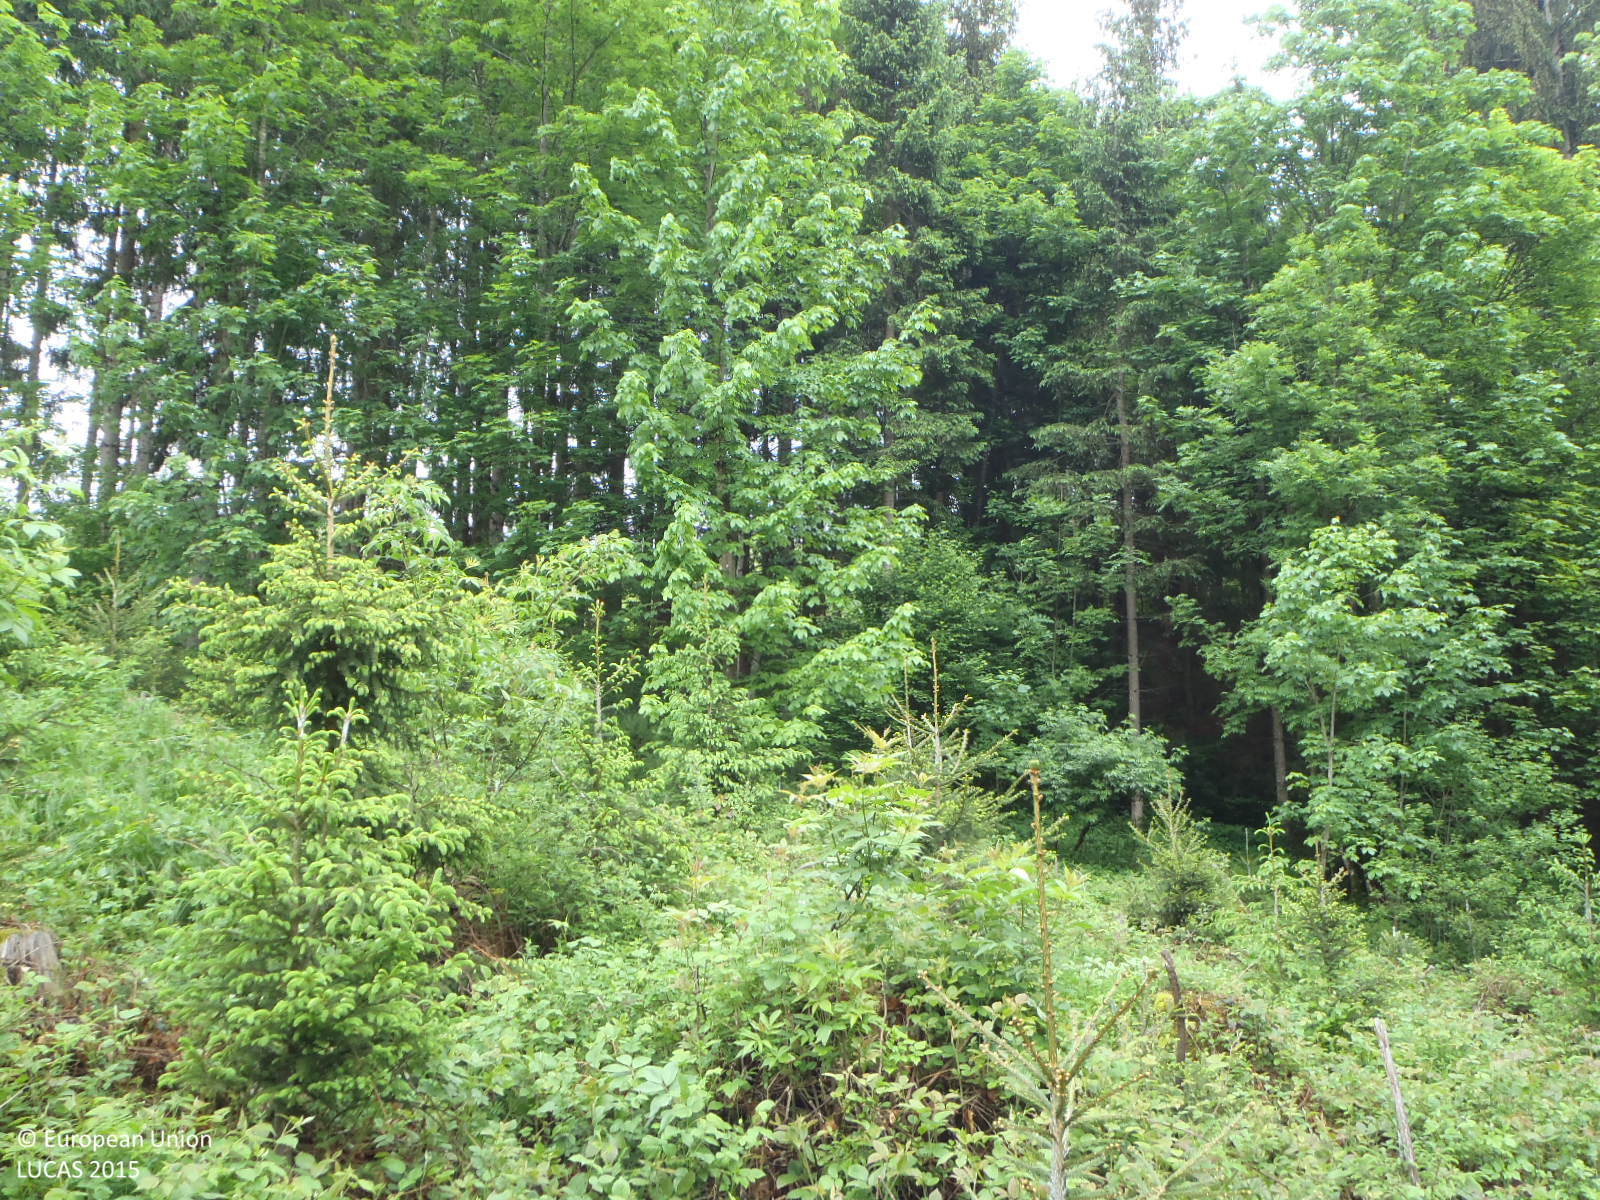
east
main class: Woodland
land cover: Other mixed woodland
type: alpine coniferous forest
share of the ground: > 75 %
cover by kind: coniferous forest trees 60 %, broadleaved forest trees 25 %, herbaceous plants 15 %
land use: Forestry
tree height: > 5 m
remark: Nursery
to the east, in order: Other mixed woodland; Spruce dominated coniferous woodland; Fences; Tracks; Fences; Grassland without tree/shrub cover; Fences; Grassland without tree/shrub cover; Artificial constructions in urban areas; Grassland without tree/shrub cover; Fences; Grassland without tree/shrub cover; Fences; Grassland without tree/shrub cover
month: May
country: AT
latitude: 47.4124
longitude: 12.8476
